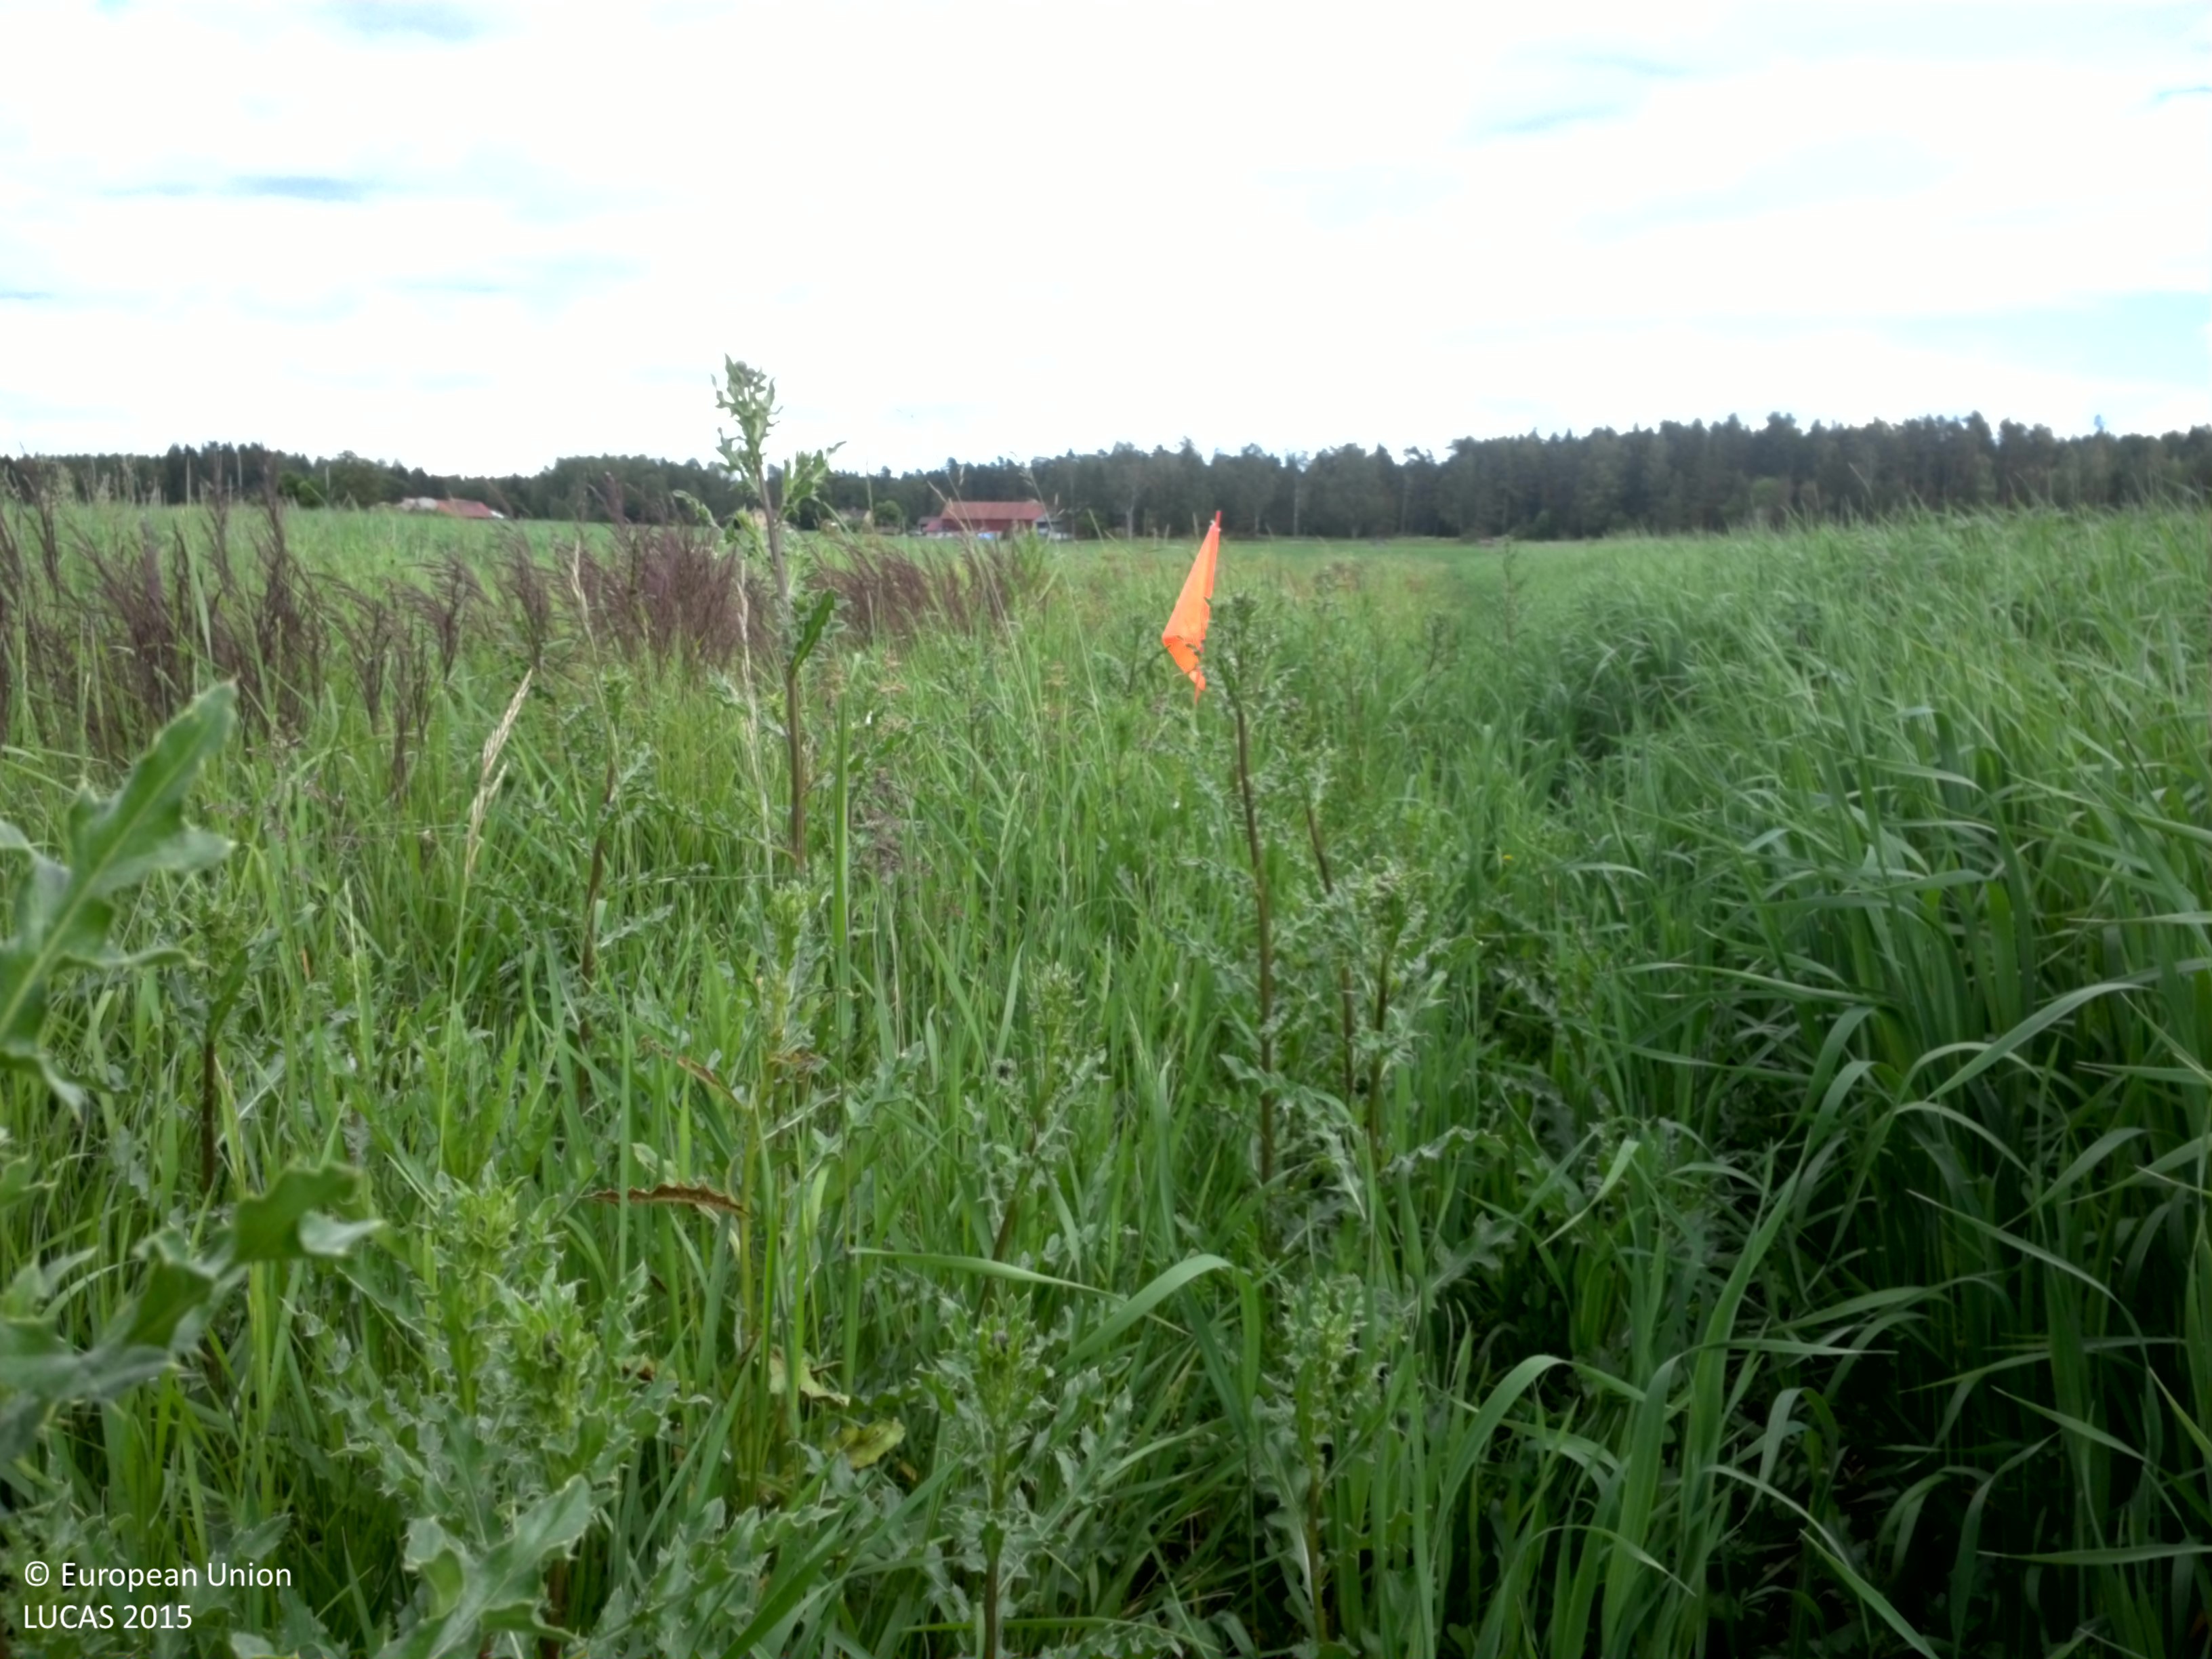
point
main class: Cropland
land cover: Oats
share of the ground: > 75 %
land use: Agriculture (excluding fallow land and kitchen gardens)
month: July
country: SE
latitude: 60.0263
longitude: 16.9719
